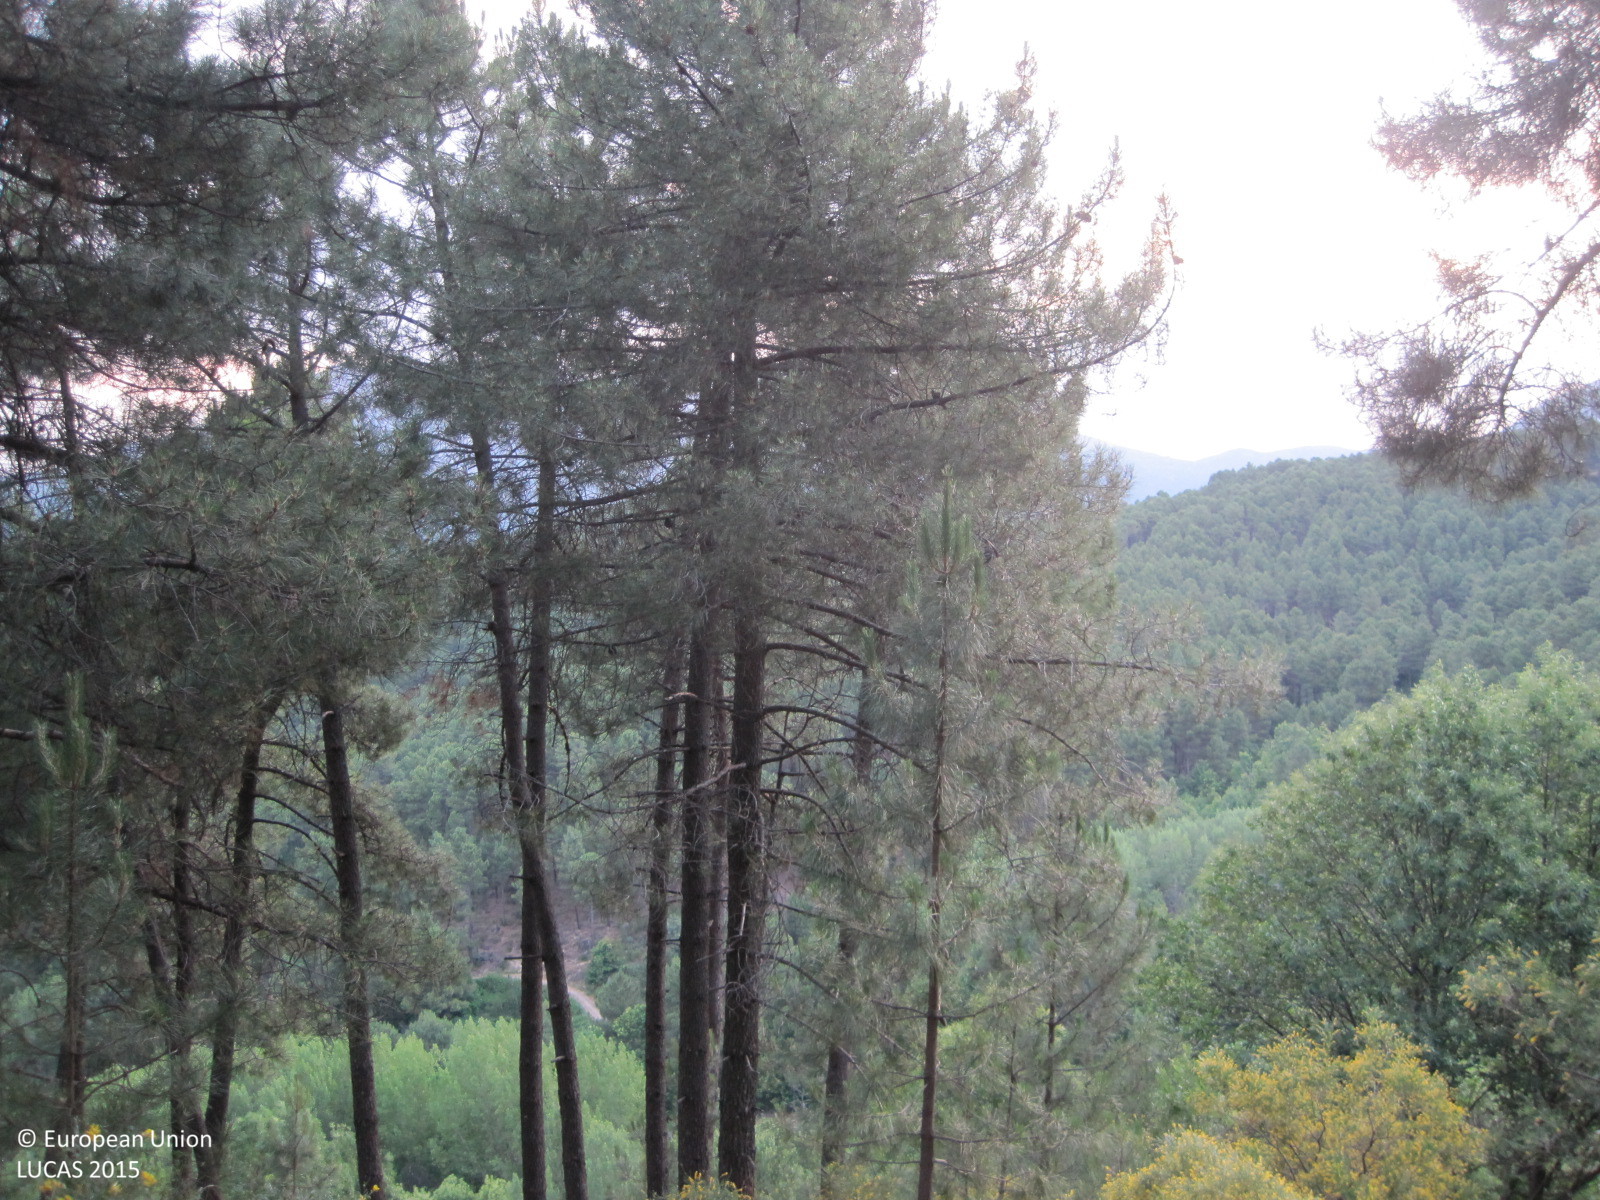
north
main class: Woodland
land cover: Pine dominated mixed woodland
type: coniferous forest of the mediterranean region
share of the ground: > 75 %
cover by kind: coniferous forest trees 50 %, broadleaved forest trees 50 %
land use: Semi-natural and natural areas not in use
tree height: > 5 m
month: June
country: ES
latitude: 40.2460
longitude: -4.9960
